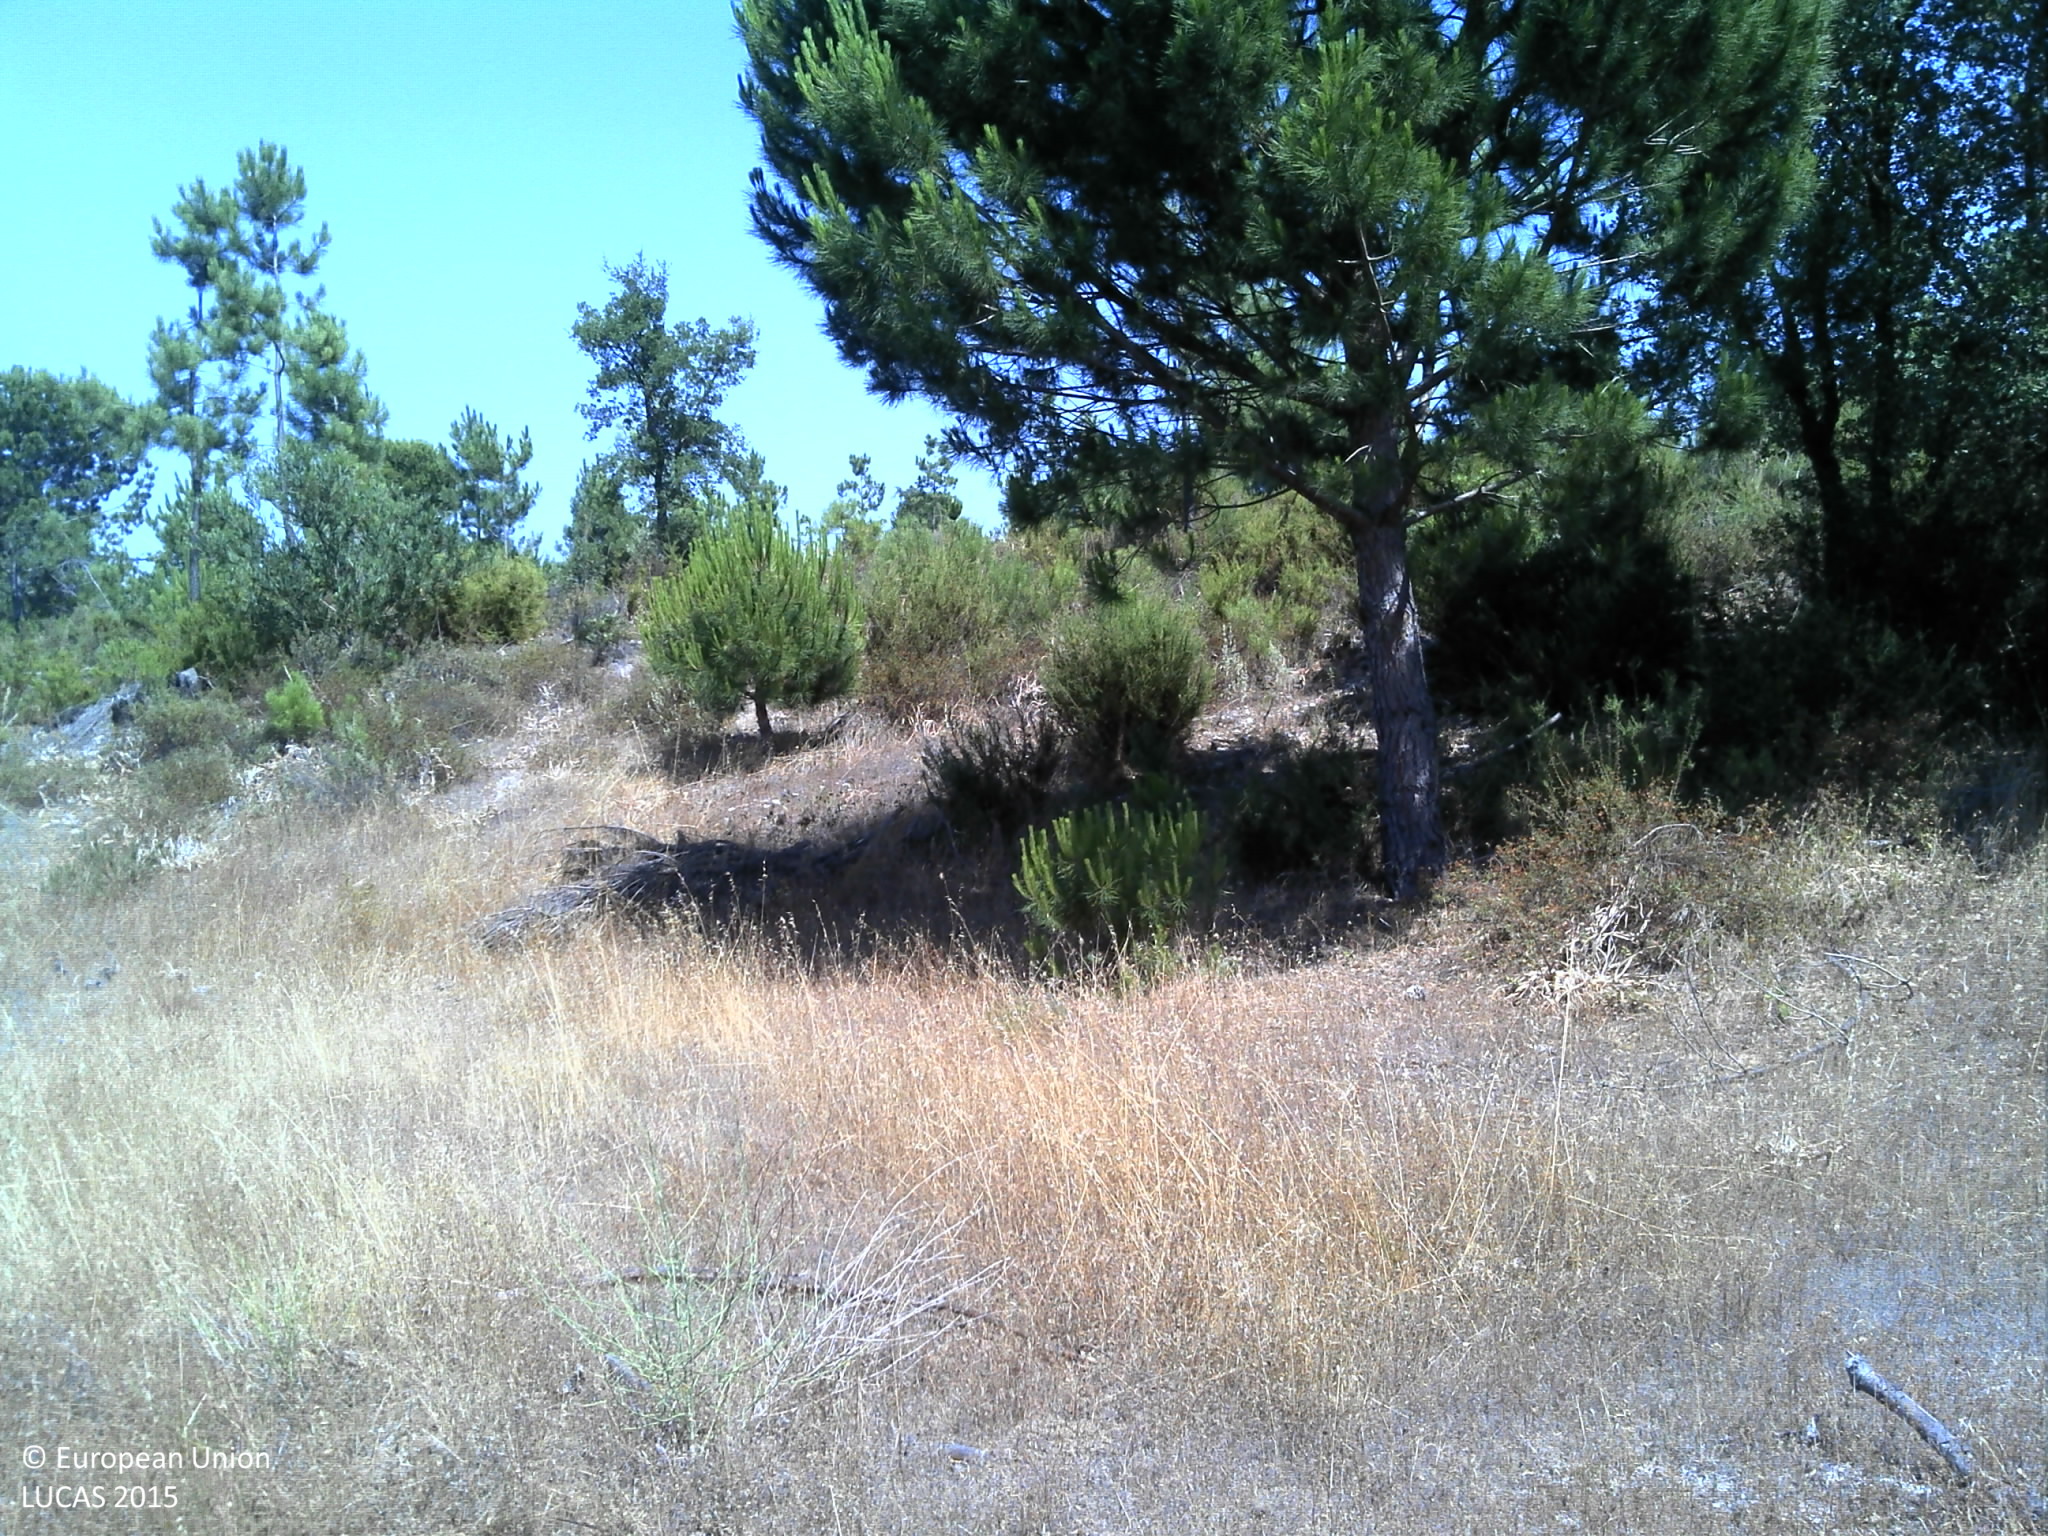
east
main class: Grassland
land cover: Grassland with sparse tree/shrub cover
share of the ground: 25 - 50 %
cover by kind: unconsolidated bare surface 60 %, herbaceous plants 35 %, coniferous forest trees 5 %
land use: Forestry
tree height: > 5 m
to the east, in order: Grassland with sparse tree/shrub cover; Tracks; Grassland with sparse tree/shrub cover; Pine dominated coniferous woodland; Broadleaved woodland; Pine dominated coniferous woodland
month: June
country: PT
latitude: 38.5812
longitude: -9.0685
